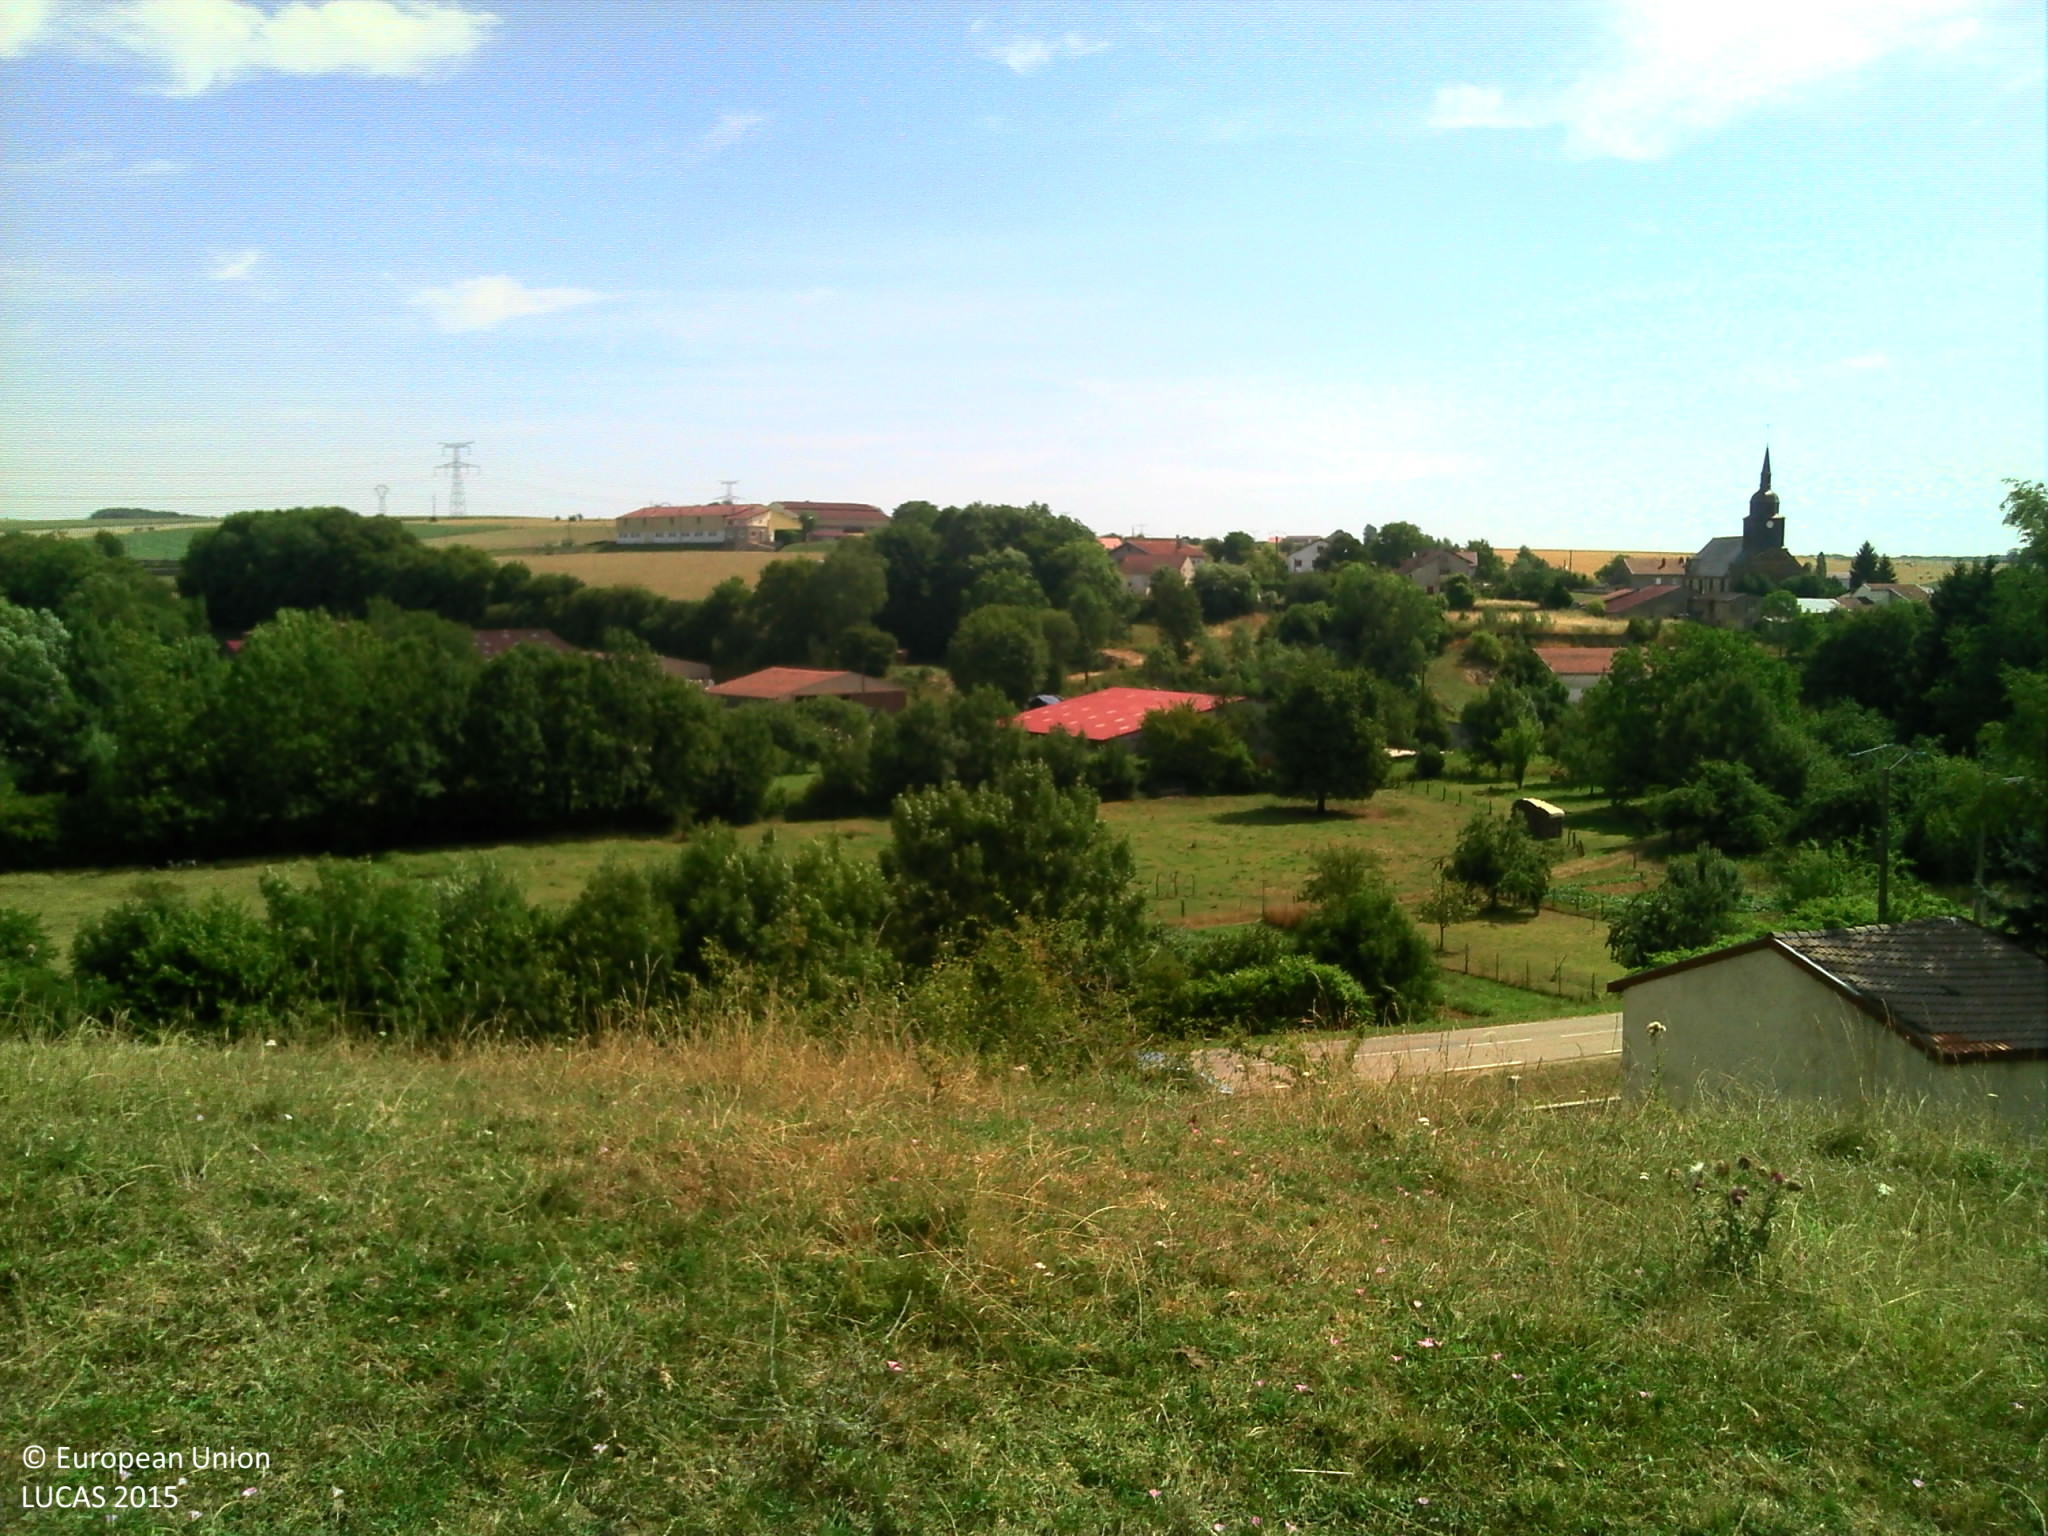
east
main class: Grassland
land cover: Grassland without tree/shrub cover
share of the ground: > 75 %
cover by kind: herbaceous plants 100 %
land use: Agriculture (excluding fallow land and kitchen gardens)
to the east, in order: Grassland without tree/shrub cover; Fences; Grassland without tree/shrub cover; Paved roads, cycling and walking lanes; Grass margins; Broadleaved woodland; Grassland without tree/shrub cover; Broadleaved woodland; Grassland without tree/shrub cover; Other fresh vegetables; Grassland without tree/shrub cover; Fences; Grassland without tree/shrub cover; Fences; Abandoned hedges; Grassland without tree/shrub cover; Artificial constructions in urban areas; Grassland without tree/shrub cover; Fences; Grass margins; Paved roads, cycling and walking lanes; Grassland without tree/shrub cover
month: August
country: FR
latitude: 49.4902
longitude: 5.2352
